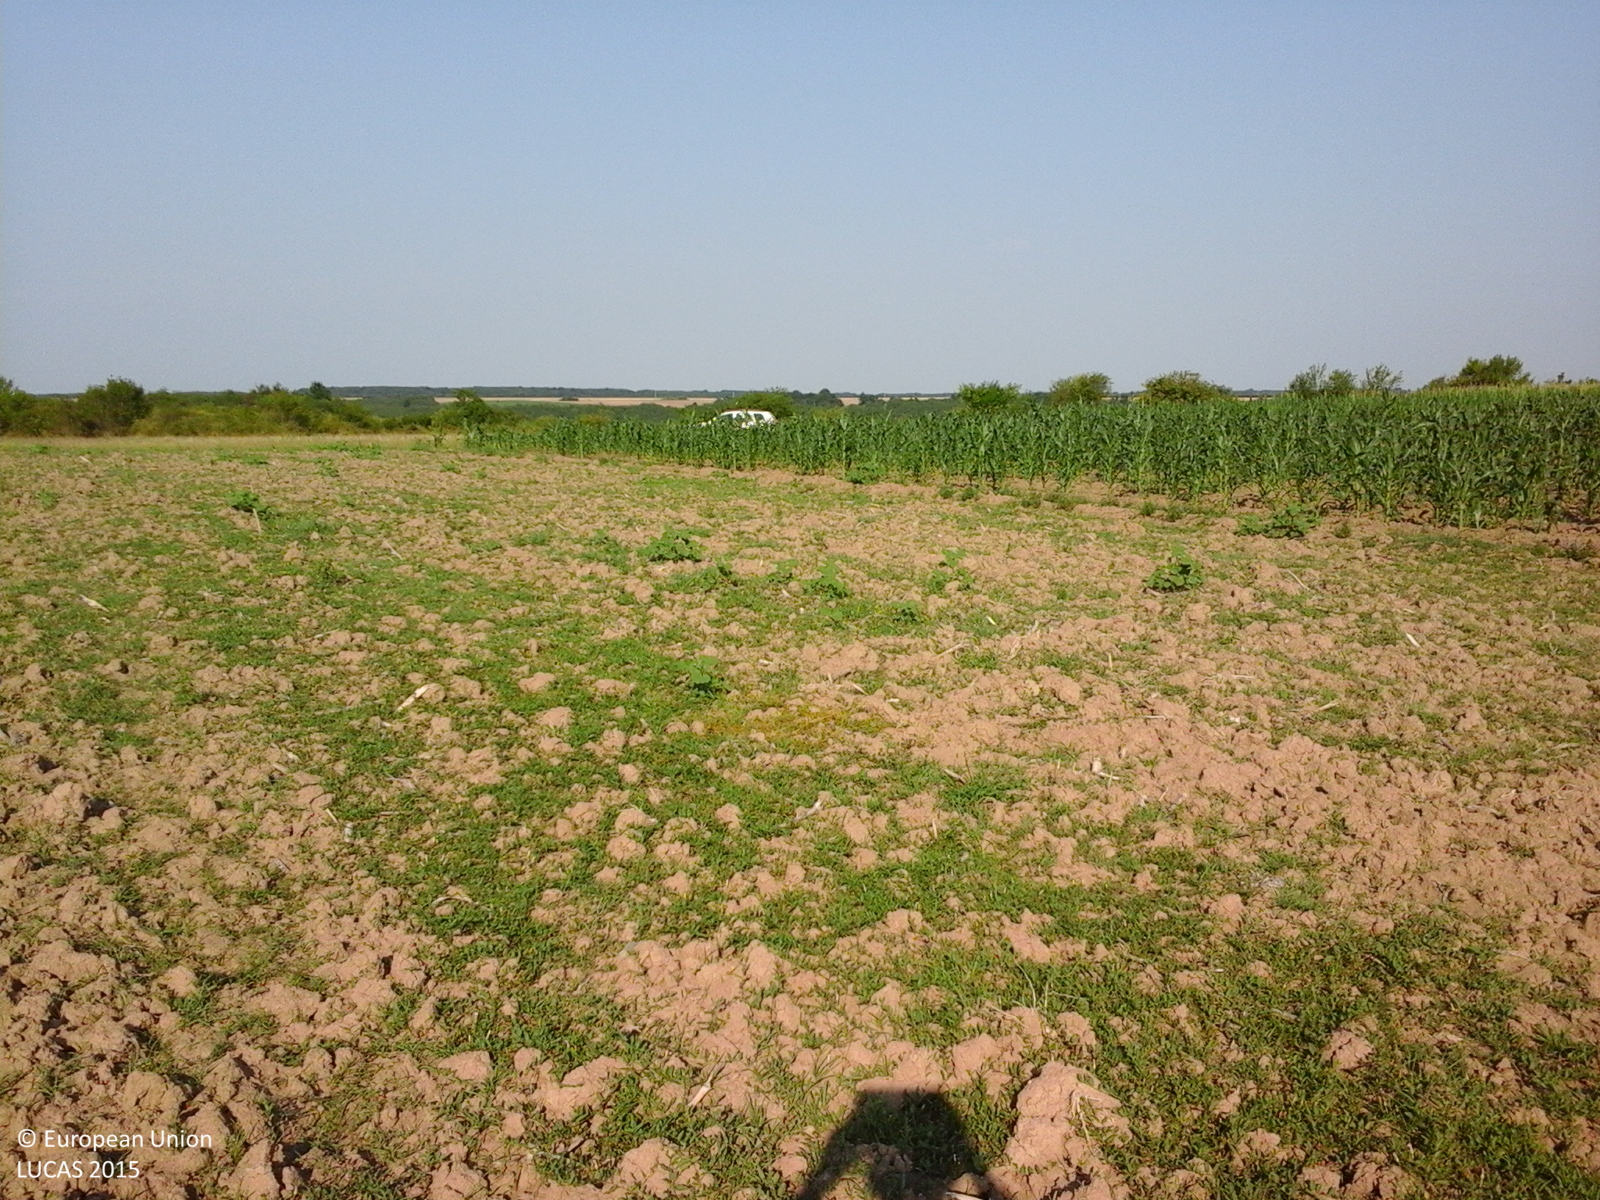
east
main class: Grassland
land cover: Spontaneously vegetated surfaces
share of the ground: 25 - 50 %
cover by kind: herbaceous plants 100 %
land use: Fallow land
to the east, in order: Spontaneously vegetated surfaces; Maize; Tracks; Grassland without tree/shrub cover; Grassland with sparse tree/shrub cover; Shrubland with sparse tree cover
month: July
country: RO
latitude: 44.7093
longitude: 24.6804
